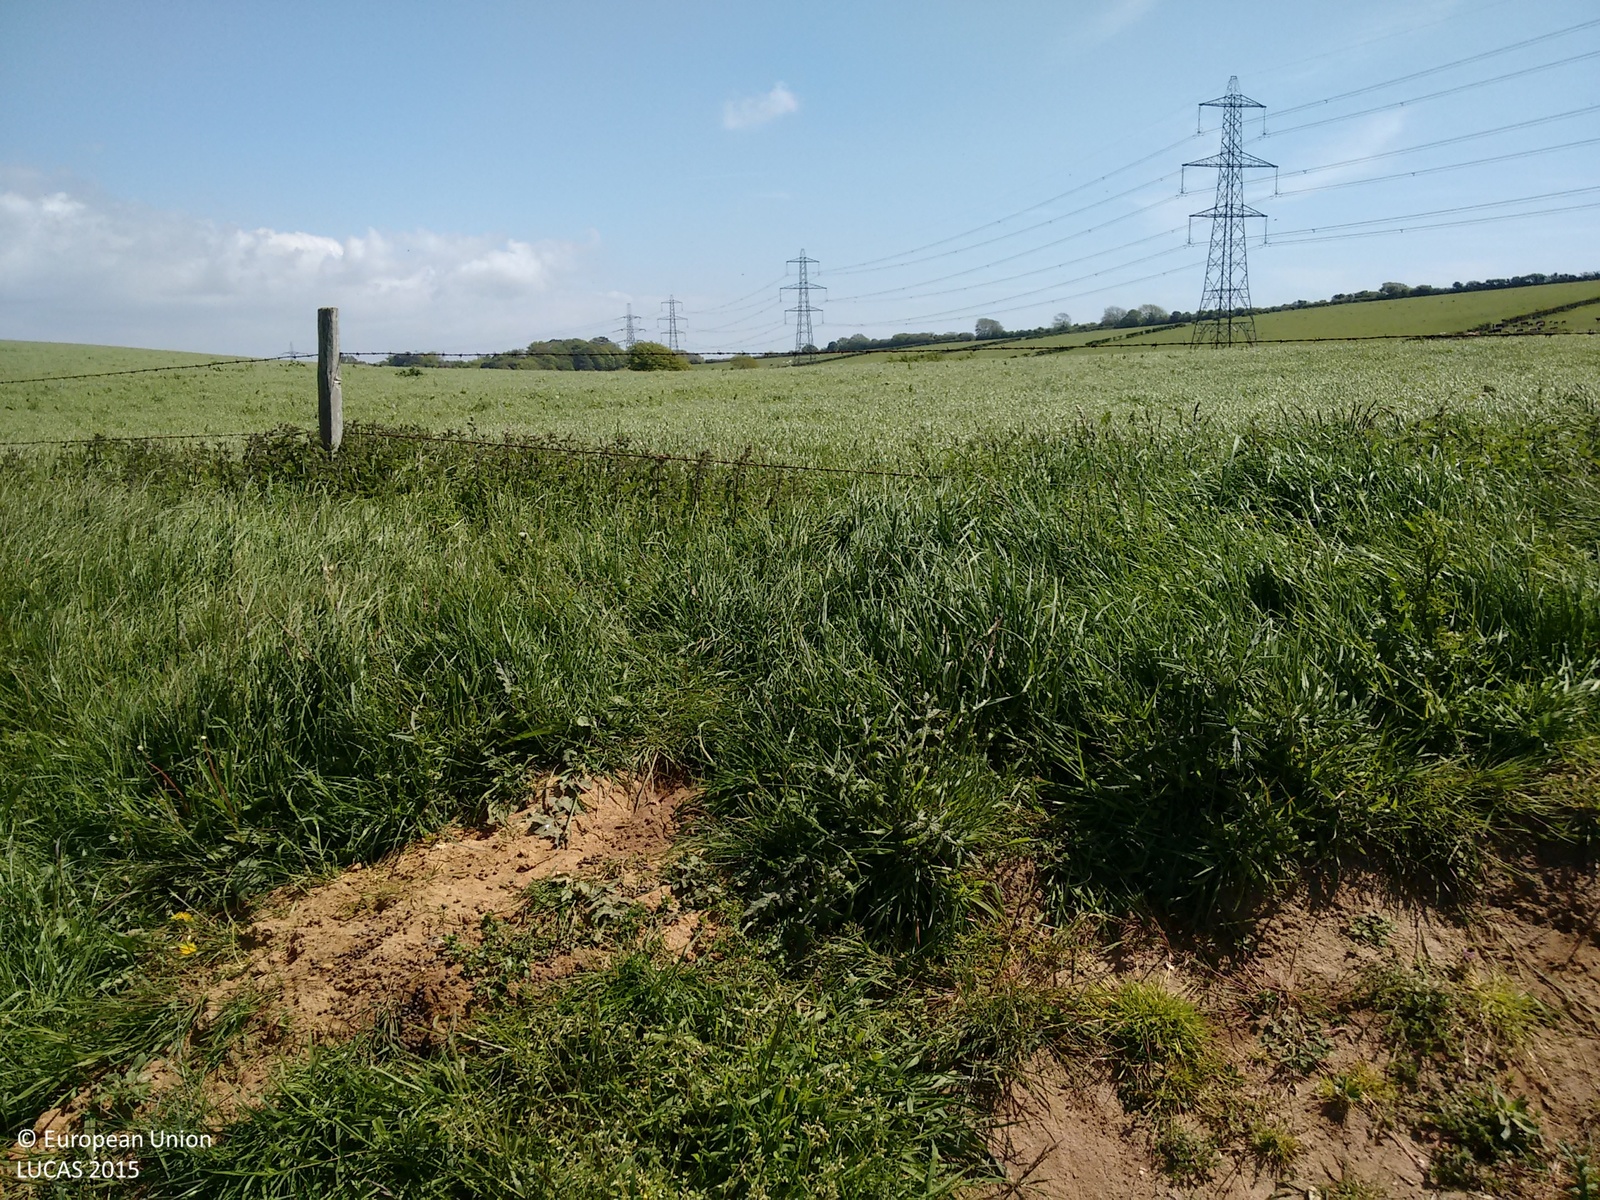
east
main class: Grassland
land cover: Grassland without tree/shrub cover
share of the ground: > 75 %
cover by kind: herbaceous plants 95 %, shrubs 5 %
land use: Agriculture (excluding fallow land and kitchen gardens)
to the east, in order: Grassland without tree/shrub cover; Fences; Grassland without tree/shrub cover; Managed hedges; Fences; Managed hedges; Grassland without tree/shrub cover
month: May
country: GB
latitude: 50.6701
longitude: -2.3882
